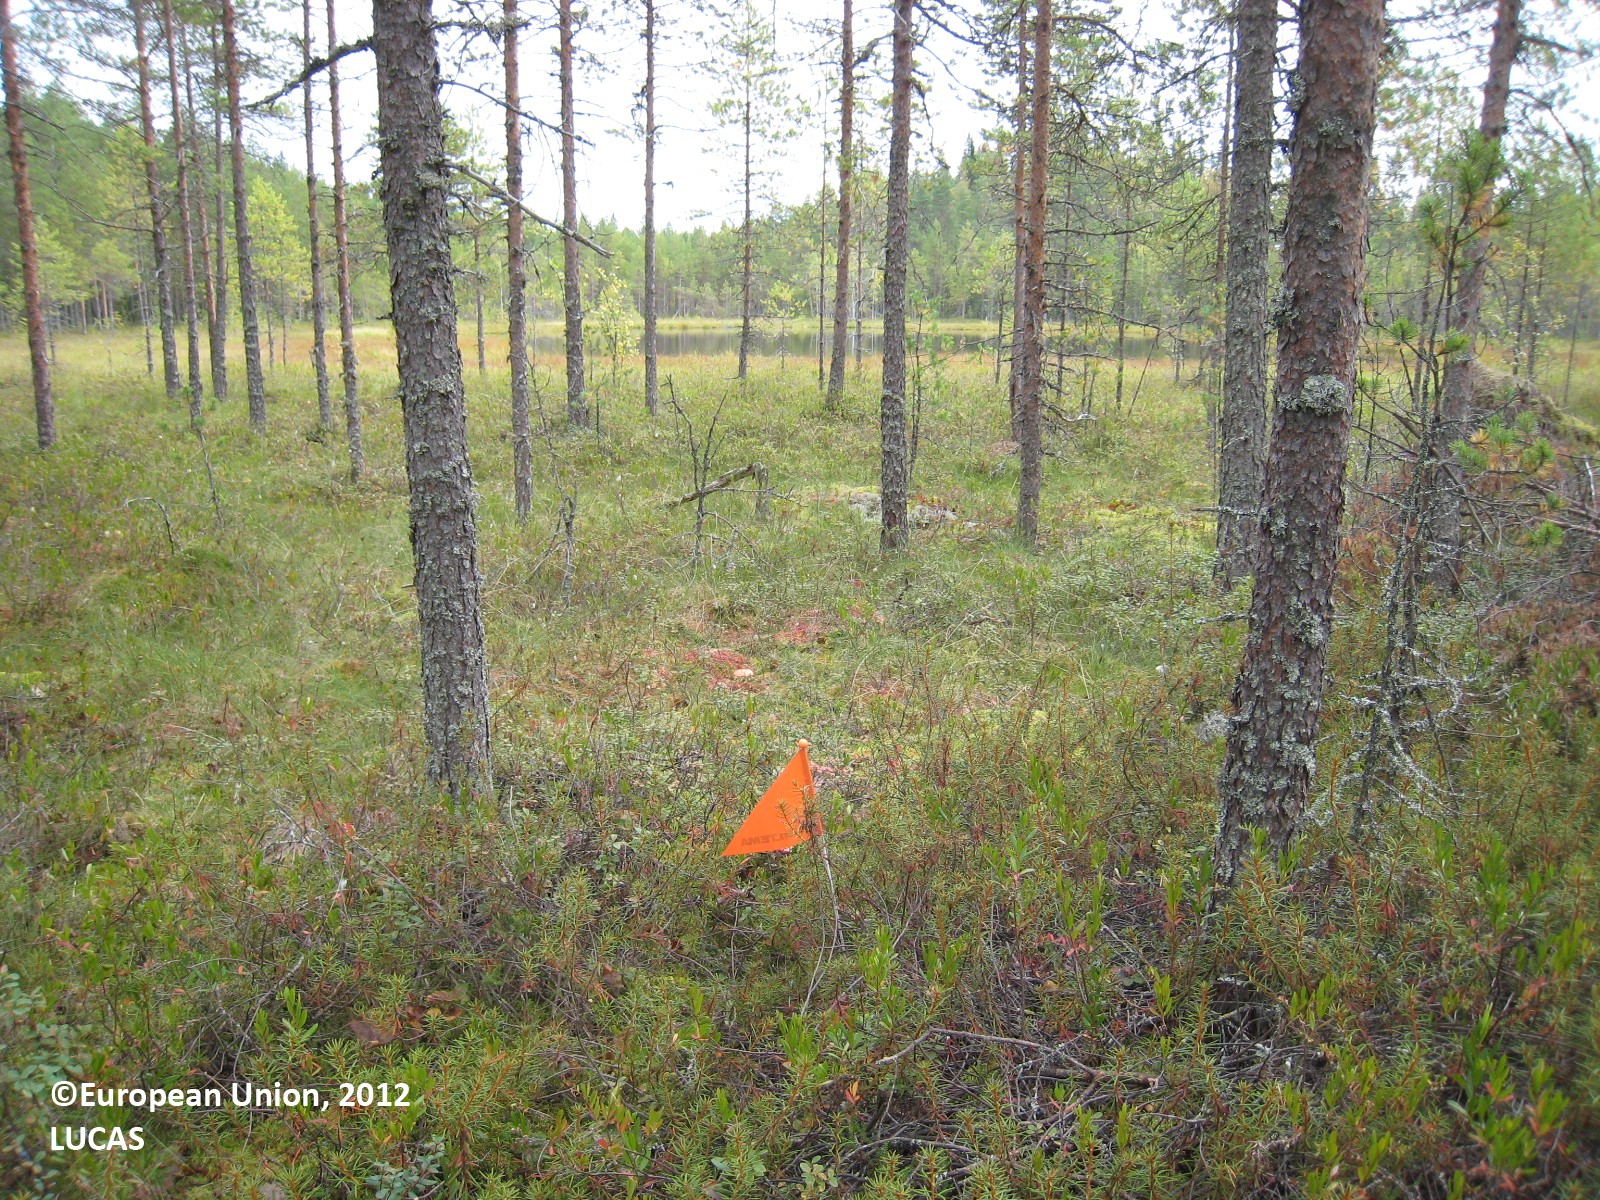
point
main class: Woodland
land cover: Pine dominated coniferous woodland
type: mire and swamp forests
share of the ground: 50 - 75 %
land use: Forestry
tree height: > 5 m
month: August
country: FI
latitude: 62.3633
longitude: 27.2632
